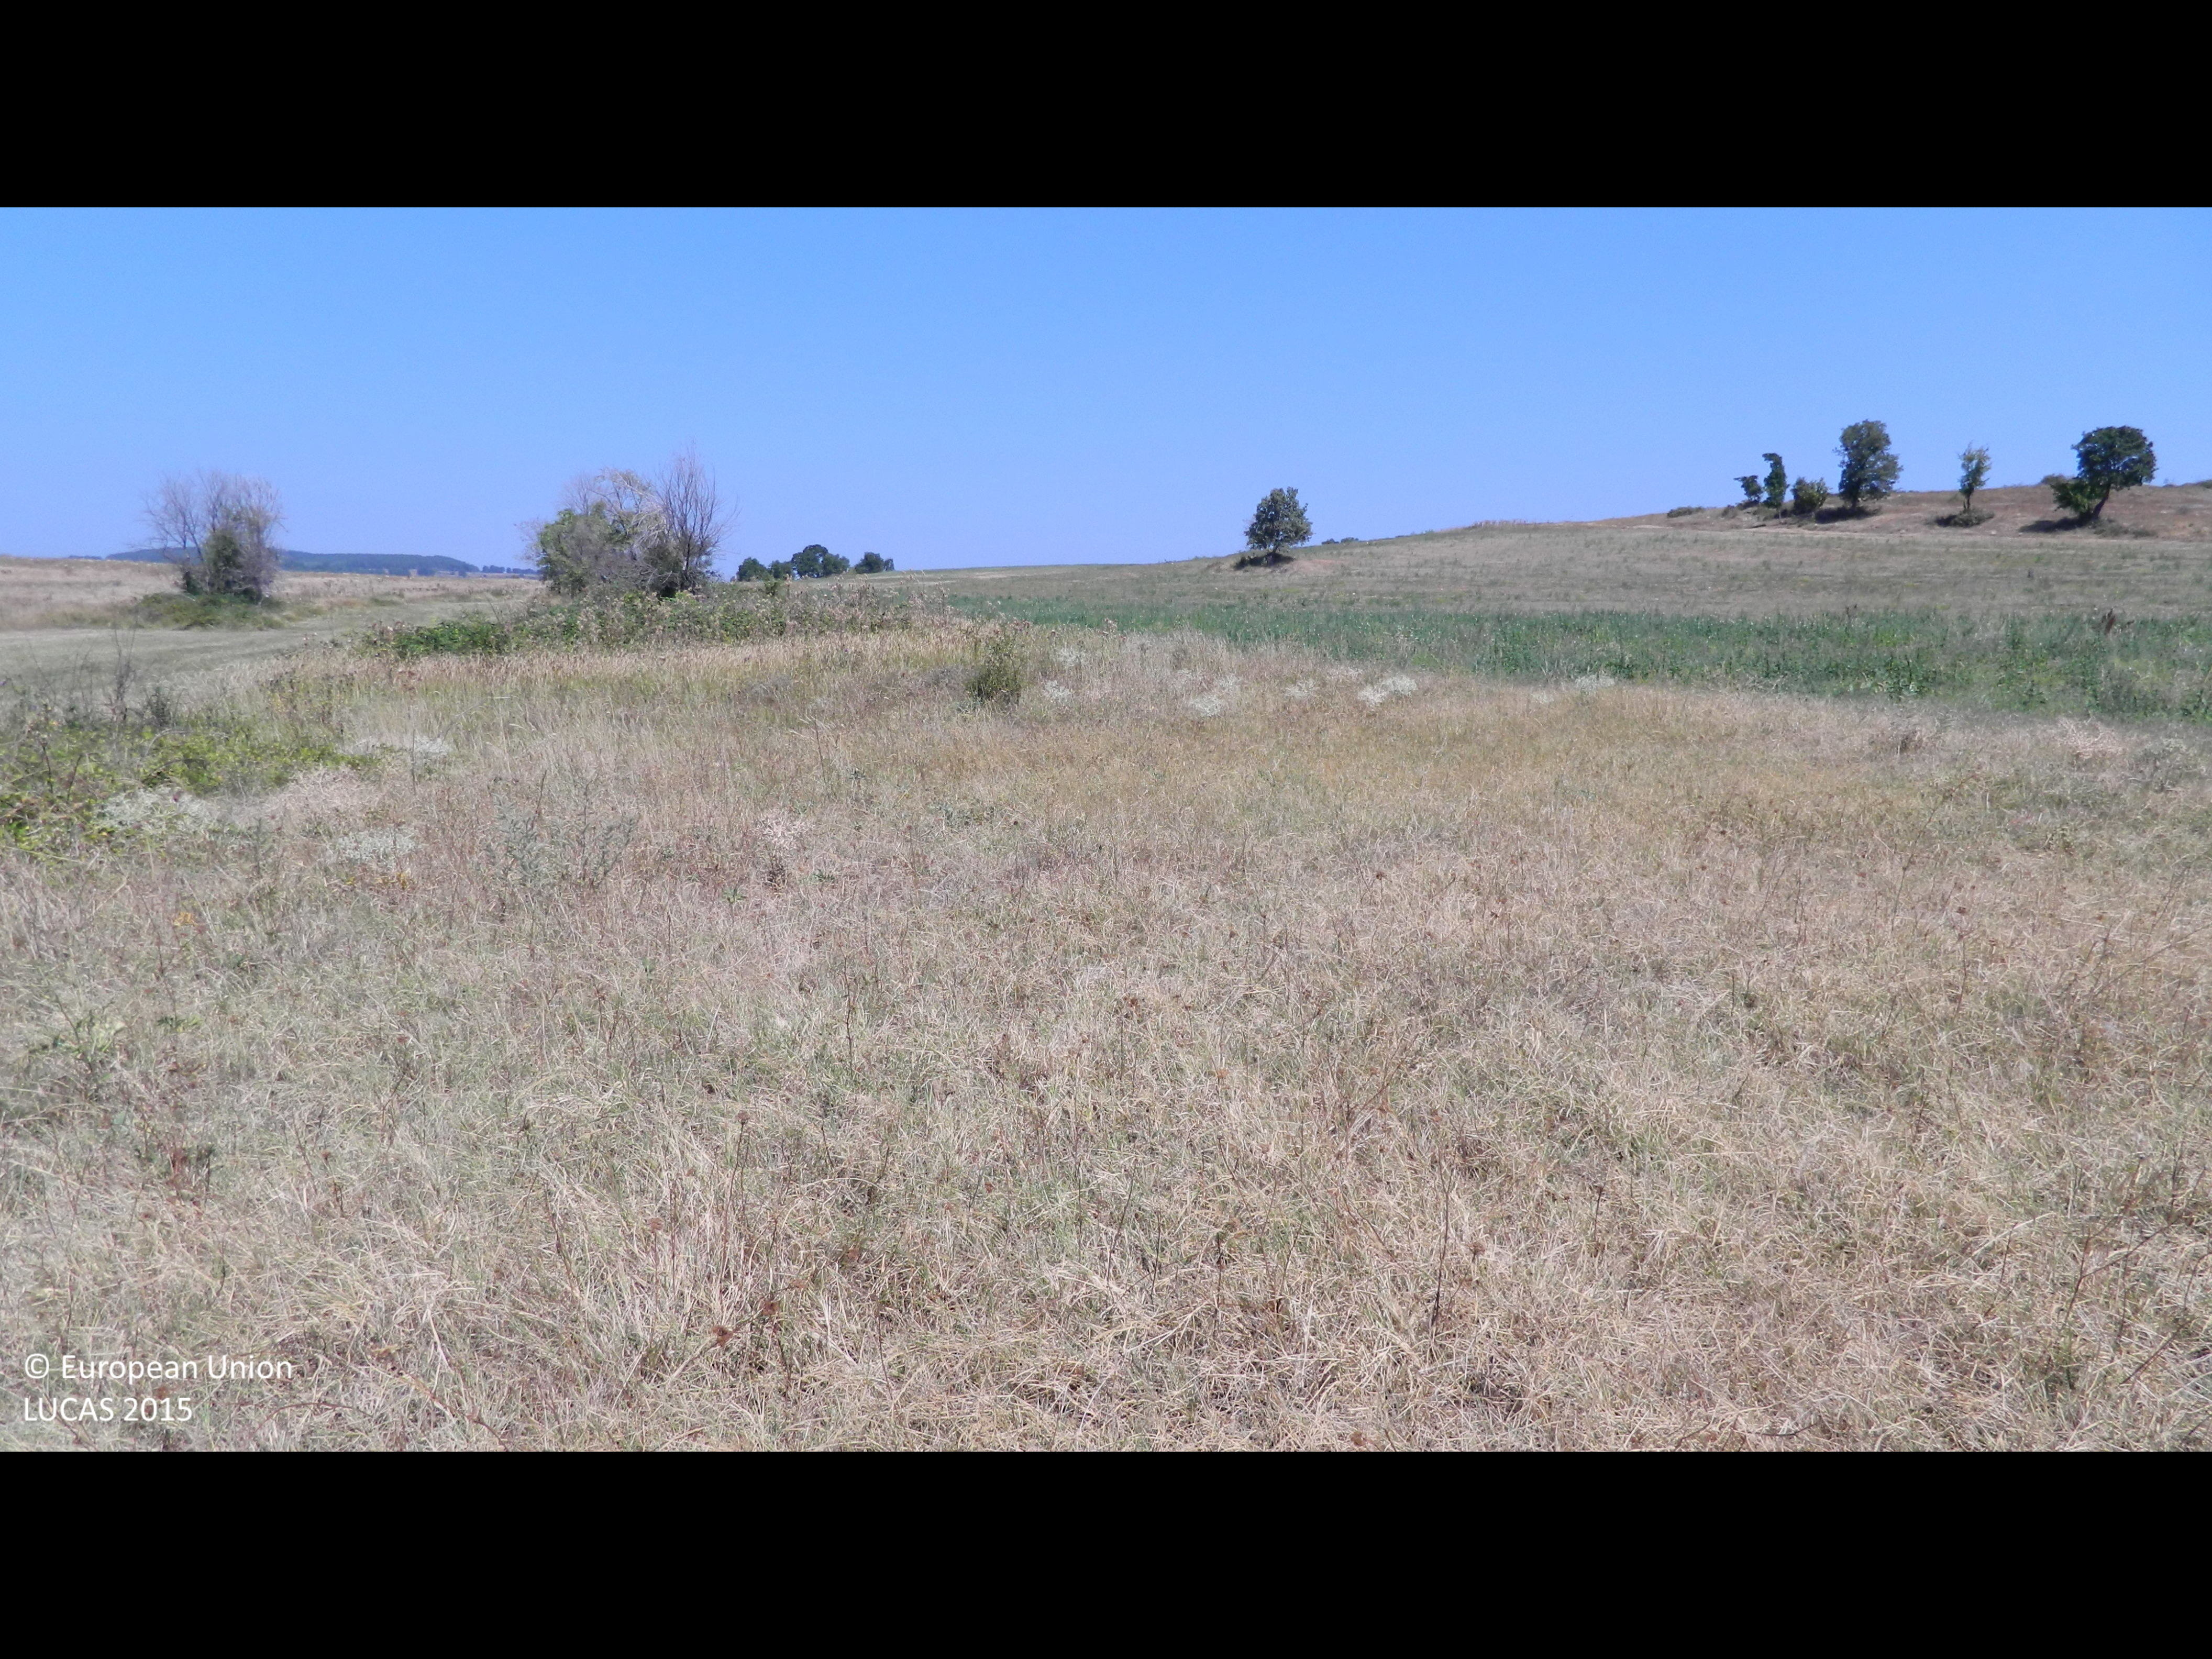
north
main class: Grassland
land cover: Grassland without tree/shrub cover
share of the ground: > 75 %
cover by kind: herbaceous plants 95 %, shrubs 5 %
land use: Agriculture (excluding fallow land and kitchen gardens)
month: August
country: BG
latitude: 41.4753
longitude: 25.9327
